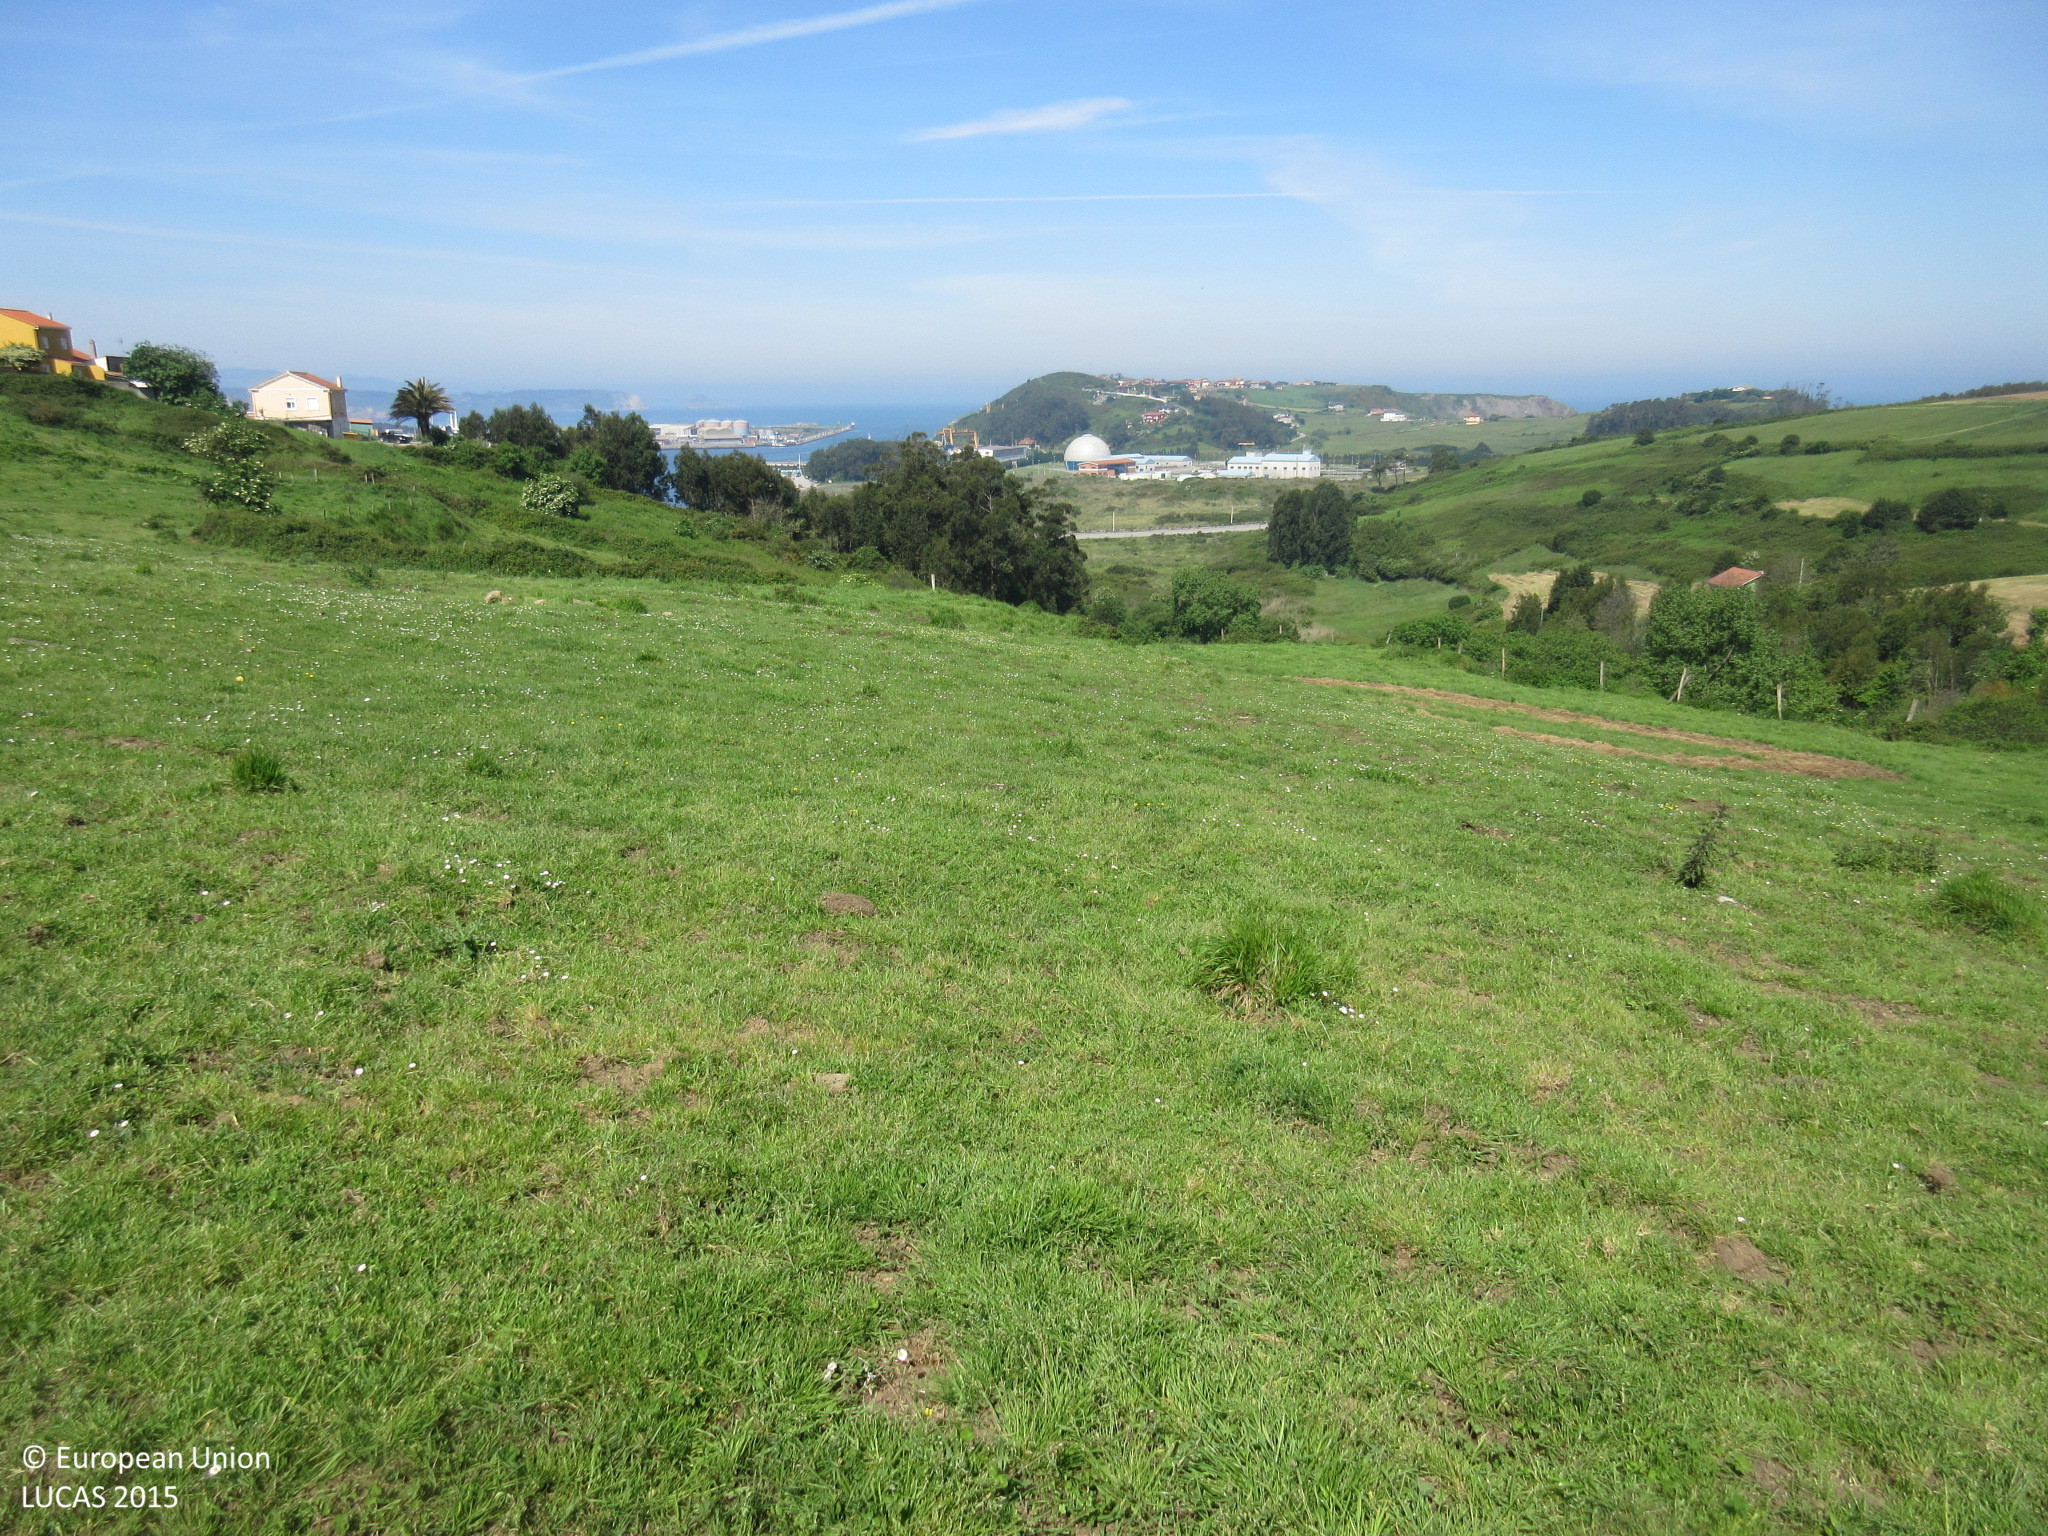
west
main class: Grassland
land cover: Grassland without tree/shrub cover
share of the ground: > 75 %
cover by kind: herbaceous plants 100 %
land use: Agriculture (excluding fallow land and kitchen gardens)
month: May
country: ES
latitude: 43.5911
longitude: -5.9087
